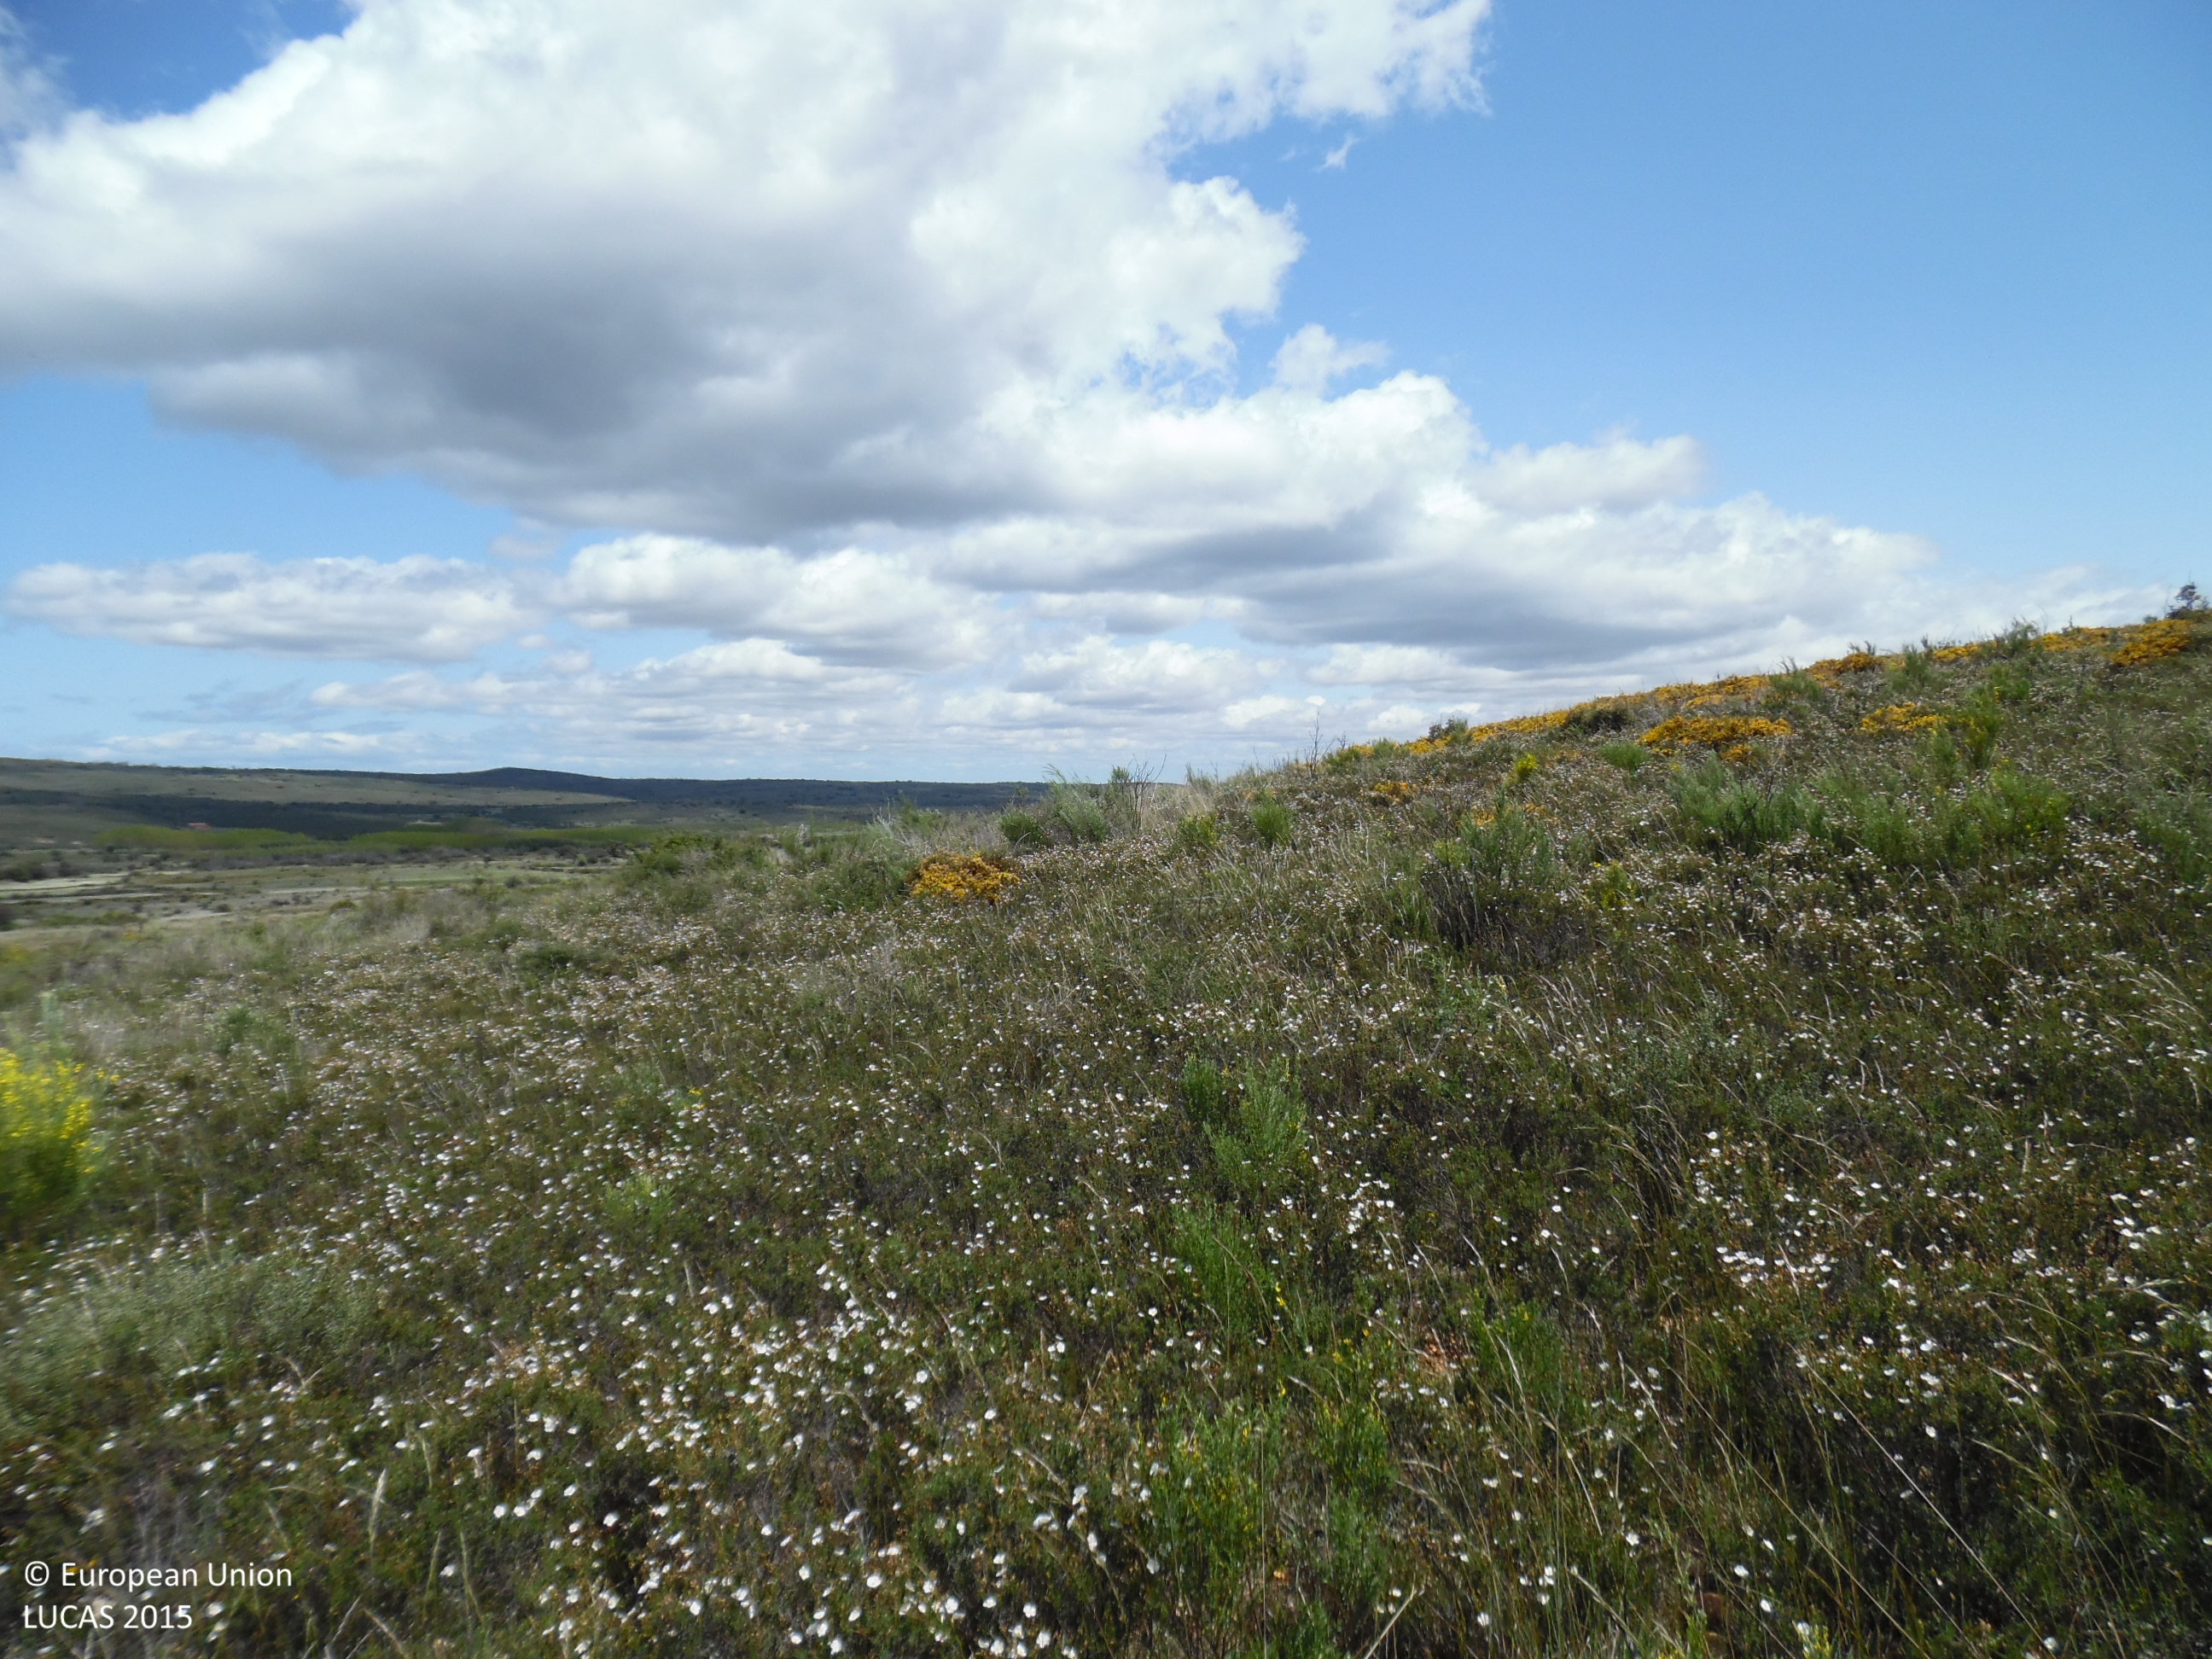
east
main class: Shrubland
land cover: Shrubland without tree cover
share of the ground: > 75 %
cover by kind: shrubs 90 %, herbaceous plants 10 %
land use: Abandoned areas
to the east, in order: Shrubland without tree cover; Dry stone walls; Shrubland without tree cover; Dry stone walls; Shrubland without tree cover; Grassland with sparse tree/shrub cover; Shrubland without tree cover
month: May
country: ES
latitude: 42.3283
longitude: -6.1120
